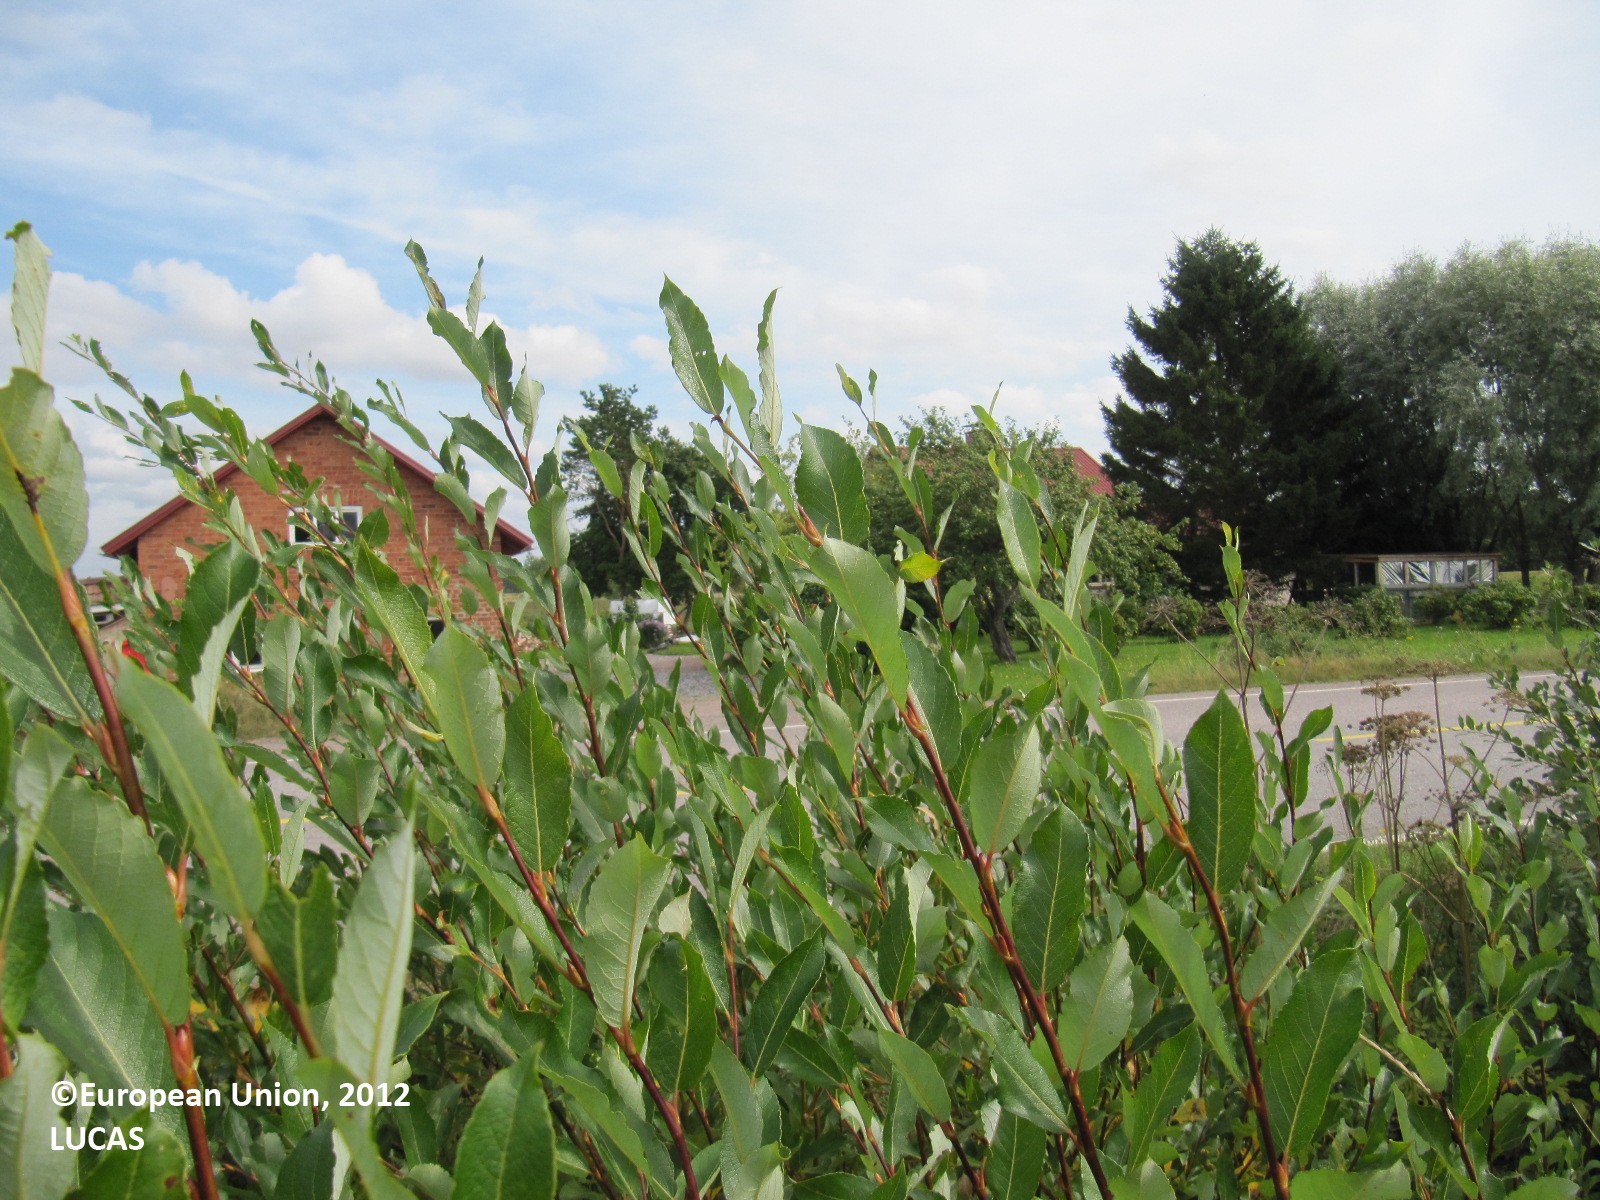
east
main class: Cropland
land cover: Rape and turnip rape
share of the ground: > 75 %
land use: Agriculture (excluding fallow land and kitchen gardens)
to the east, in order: Rape and turnip rape; Grass margins; Ditches and canals; Groves; Grass margins; Paved roads, cycling and walking lanes; Grassland with sparse tree/shrub cover; Artificial constructions in urban areas; Dry pulses; Electric lines; Dry pulses; Ditches and canals; Grassland with sparse tree/shrub cover
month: August
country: FI
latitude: 60.9237
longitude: 22.8564
